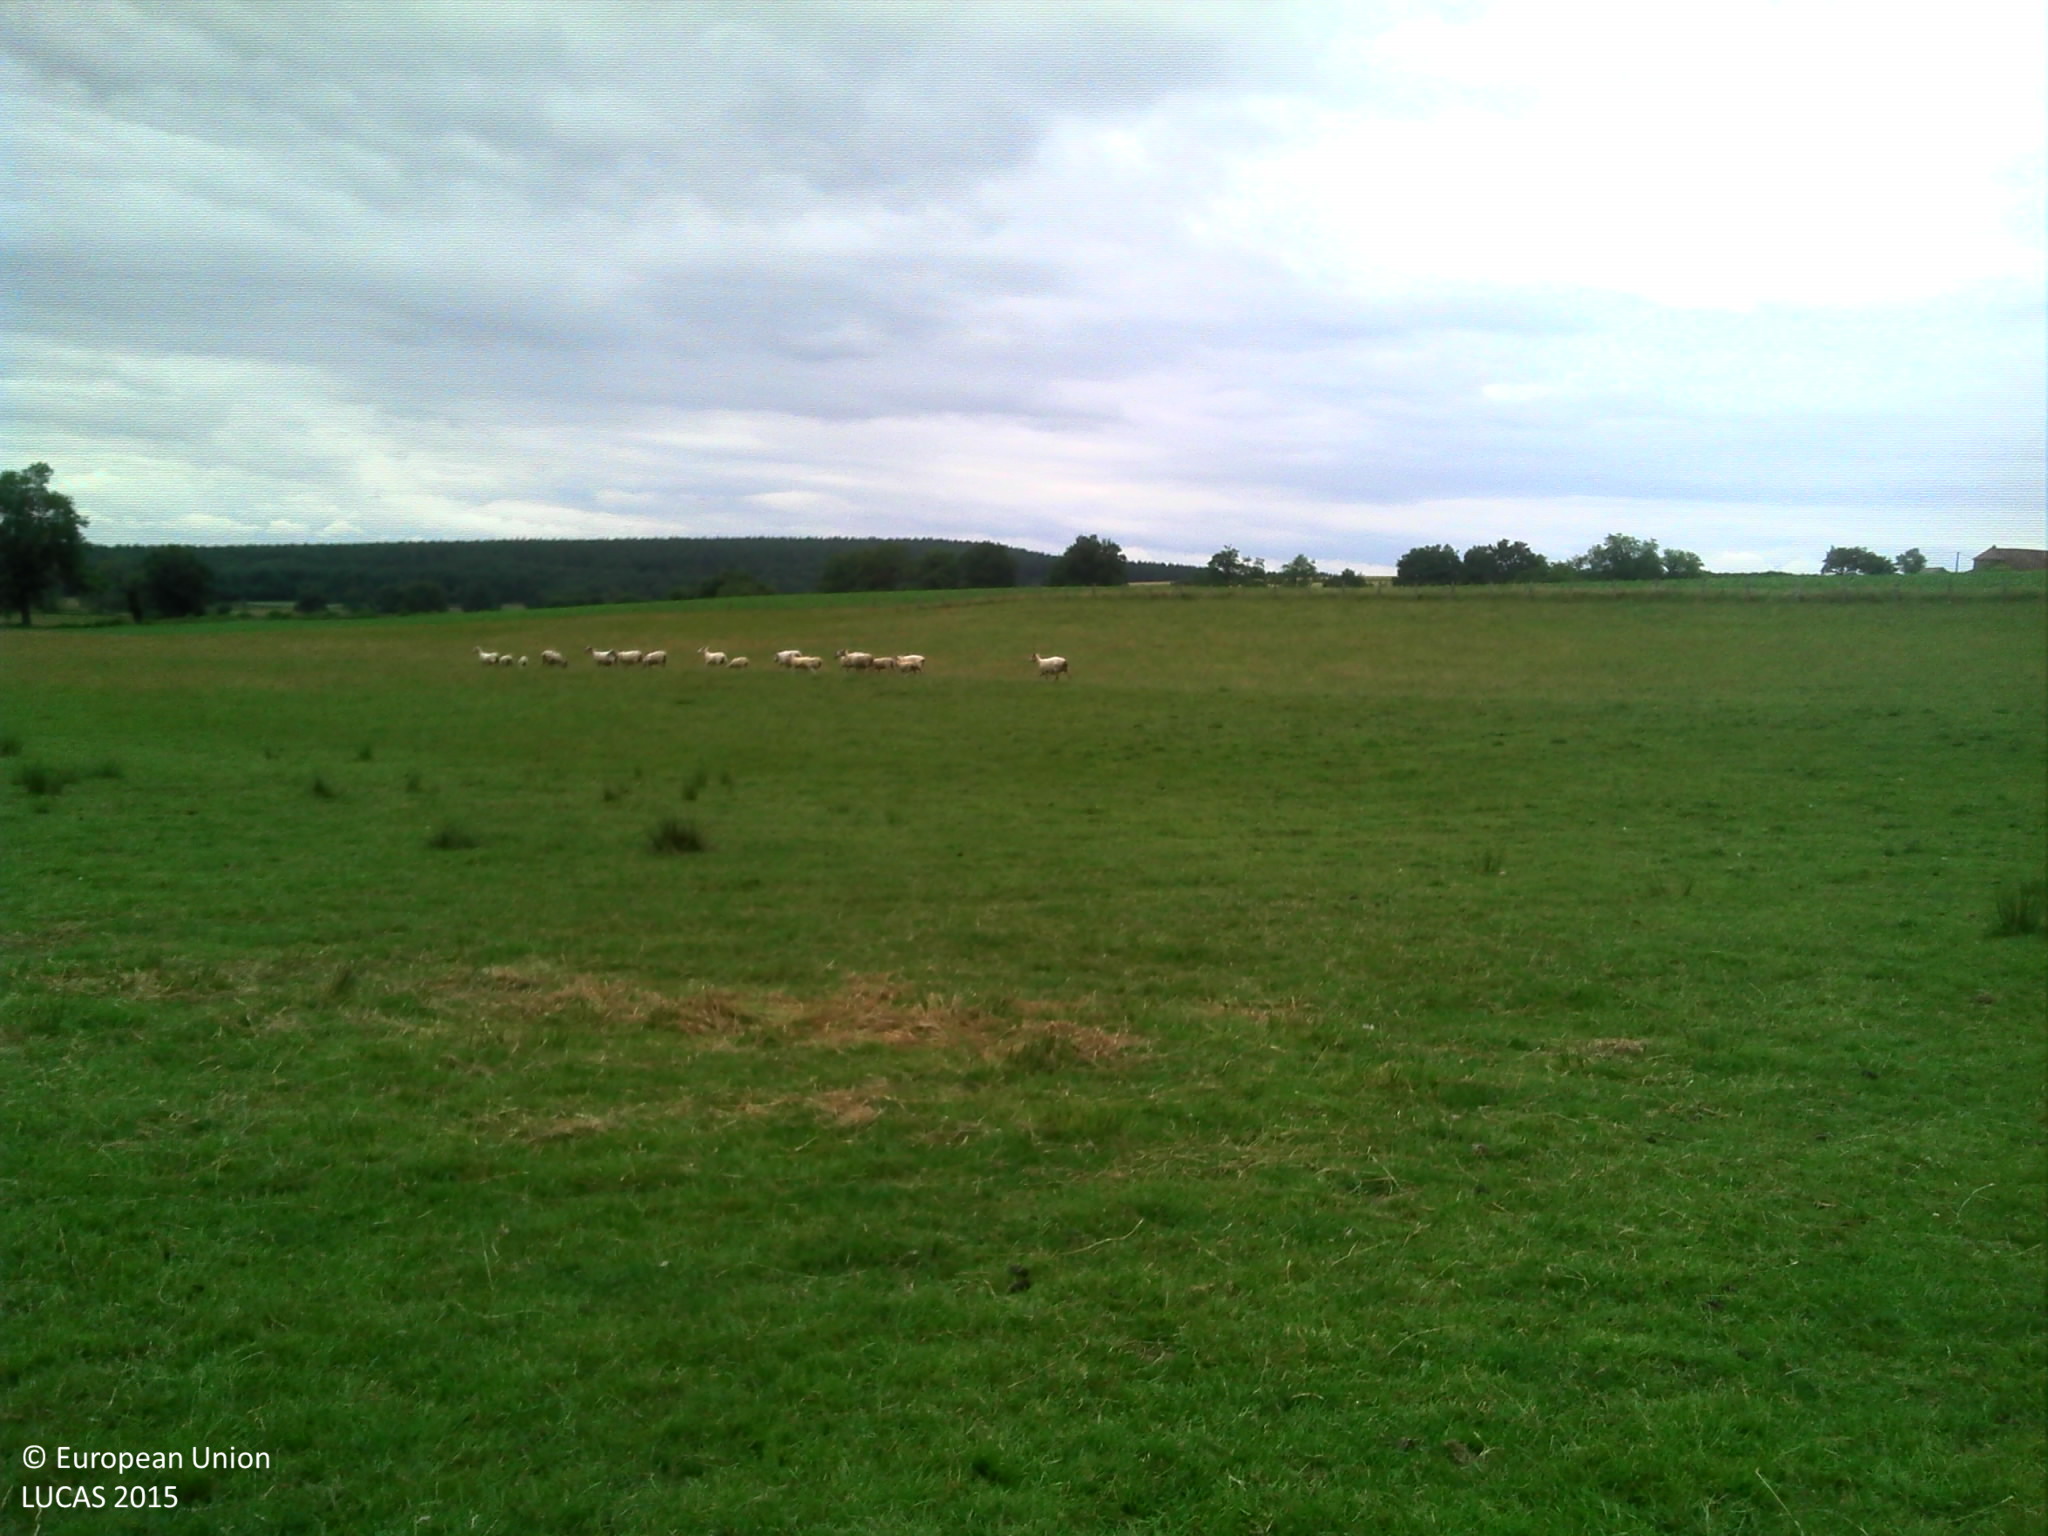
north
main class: Grassland
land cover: Grassland without tree/shrub cover
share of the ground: > 75 %
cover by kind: herbaceous plants 100 %
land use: Agriculture (excluding fallow land and kitchen gardens)
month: June
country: FR
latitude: 46.5505
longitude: 4.4581
